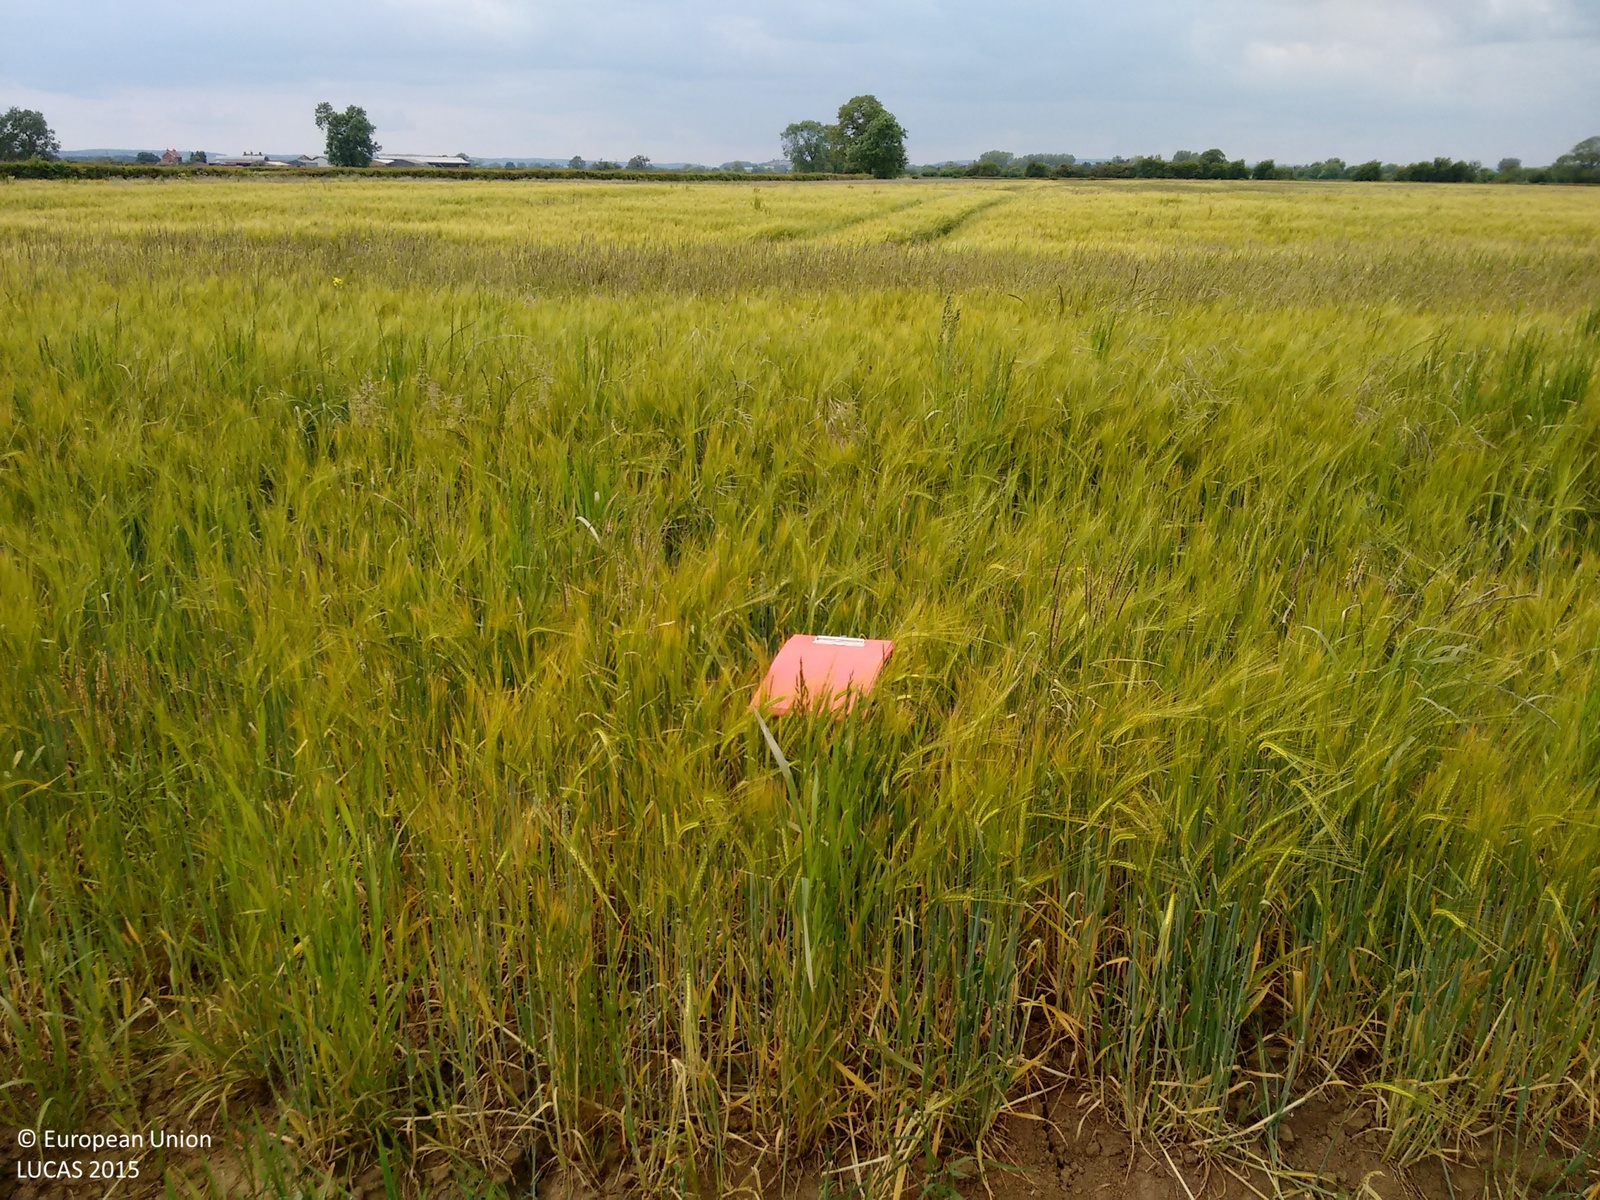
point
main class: Cropland
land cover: Barley
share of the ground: > 75 %
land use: Agriculture (excluding fallow land and kitchen gardens)
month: June
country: GB
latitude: 54.1989
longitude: -0.8783
